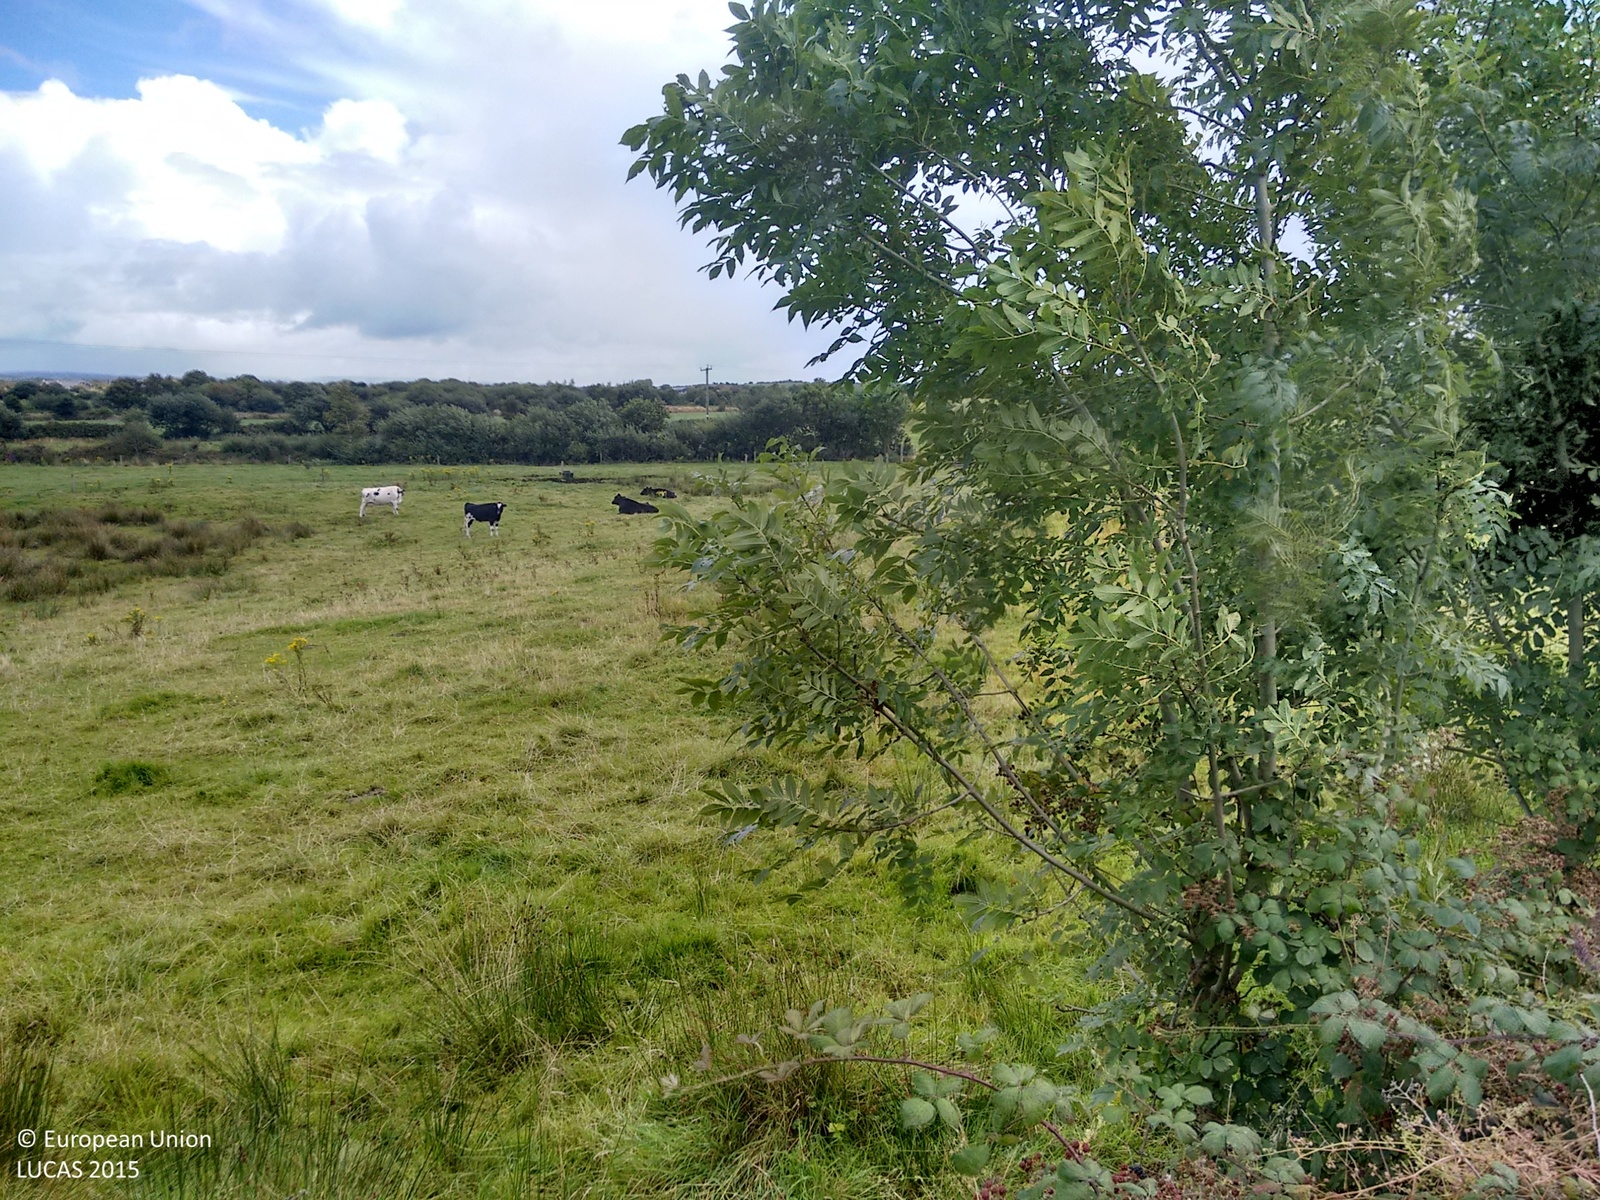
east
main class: Grassland
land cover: Grassland without tree/shrub cover
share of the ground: > 75 %
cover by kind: herbaceous plants 100 %
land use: Agriculture (excluding fallow land and kitchen gardens)
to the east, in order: Grassland without tree/shrub cover; Fences; Grassland without tree/shrub cover; Fences; Abandoned hedges; Grassland without tree/shrub cover; Electric lines; Grassland without tree/shrub cover; Fences; Abandoned hedges; Grassland without tree/shrub cover; Abandoned hedges; Spontaneously vegetated surfaces; Abandoned hedges; Grassland without tree/shrub cover; Abandoned hedges; Grass margins; Broadleaved woodland
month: August
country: IE
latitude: 52.0858
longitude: -9.8470
